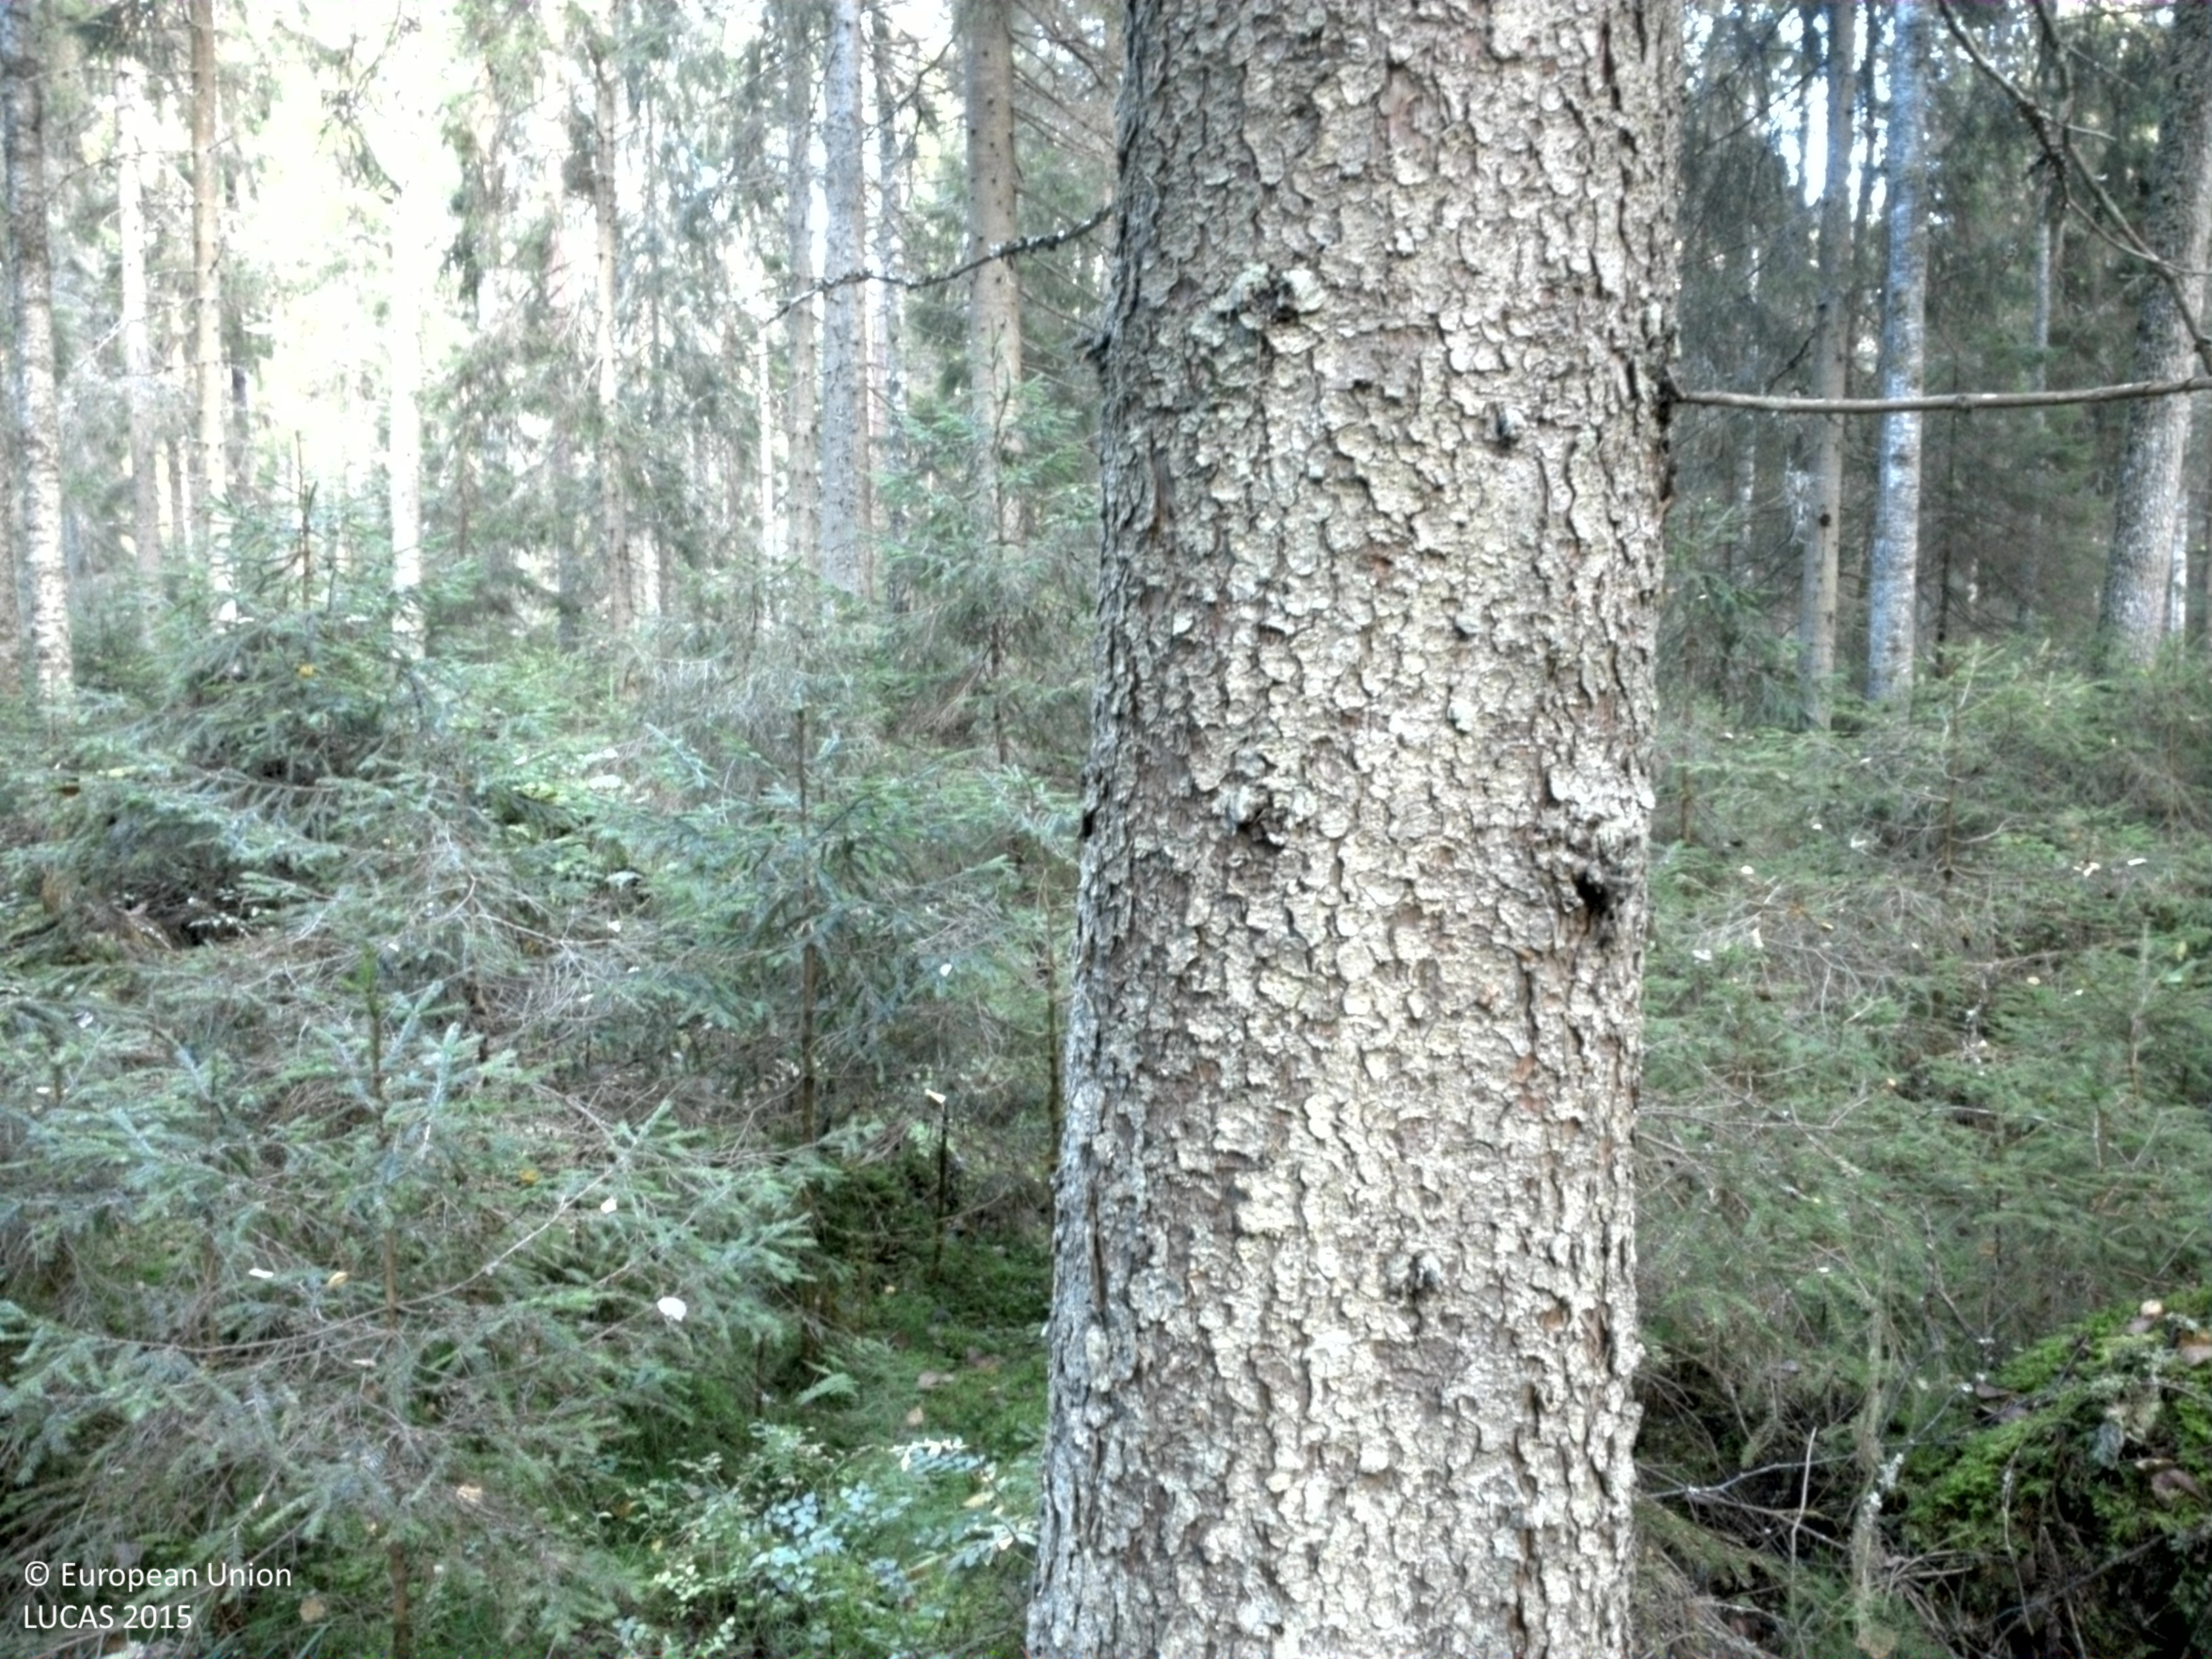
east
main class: Woodland
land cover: Spruce dominated mixed woodland
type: boreal forest
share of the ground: 50 - 75 %
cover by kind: coniferous forest trees 45 %, lichens and mosses 30 %, broadleaved forest trees 15 %, herbaceous plants 10 %
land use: Forestry
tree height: > 5 m
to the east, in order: Spruce dominated mixed woodland; Spruce dominated coniferous woodland; Ditches and canals; Spruce dominated coniferous woodland; Ditches and canals; Spruce dominated coniferous woodland
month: September
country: SE
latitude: 60.1347
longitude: 16.5975
